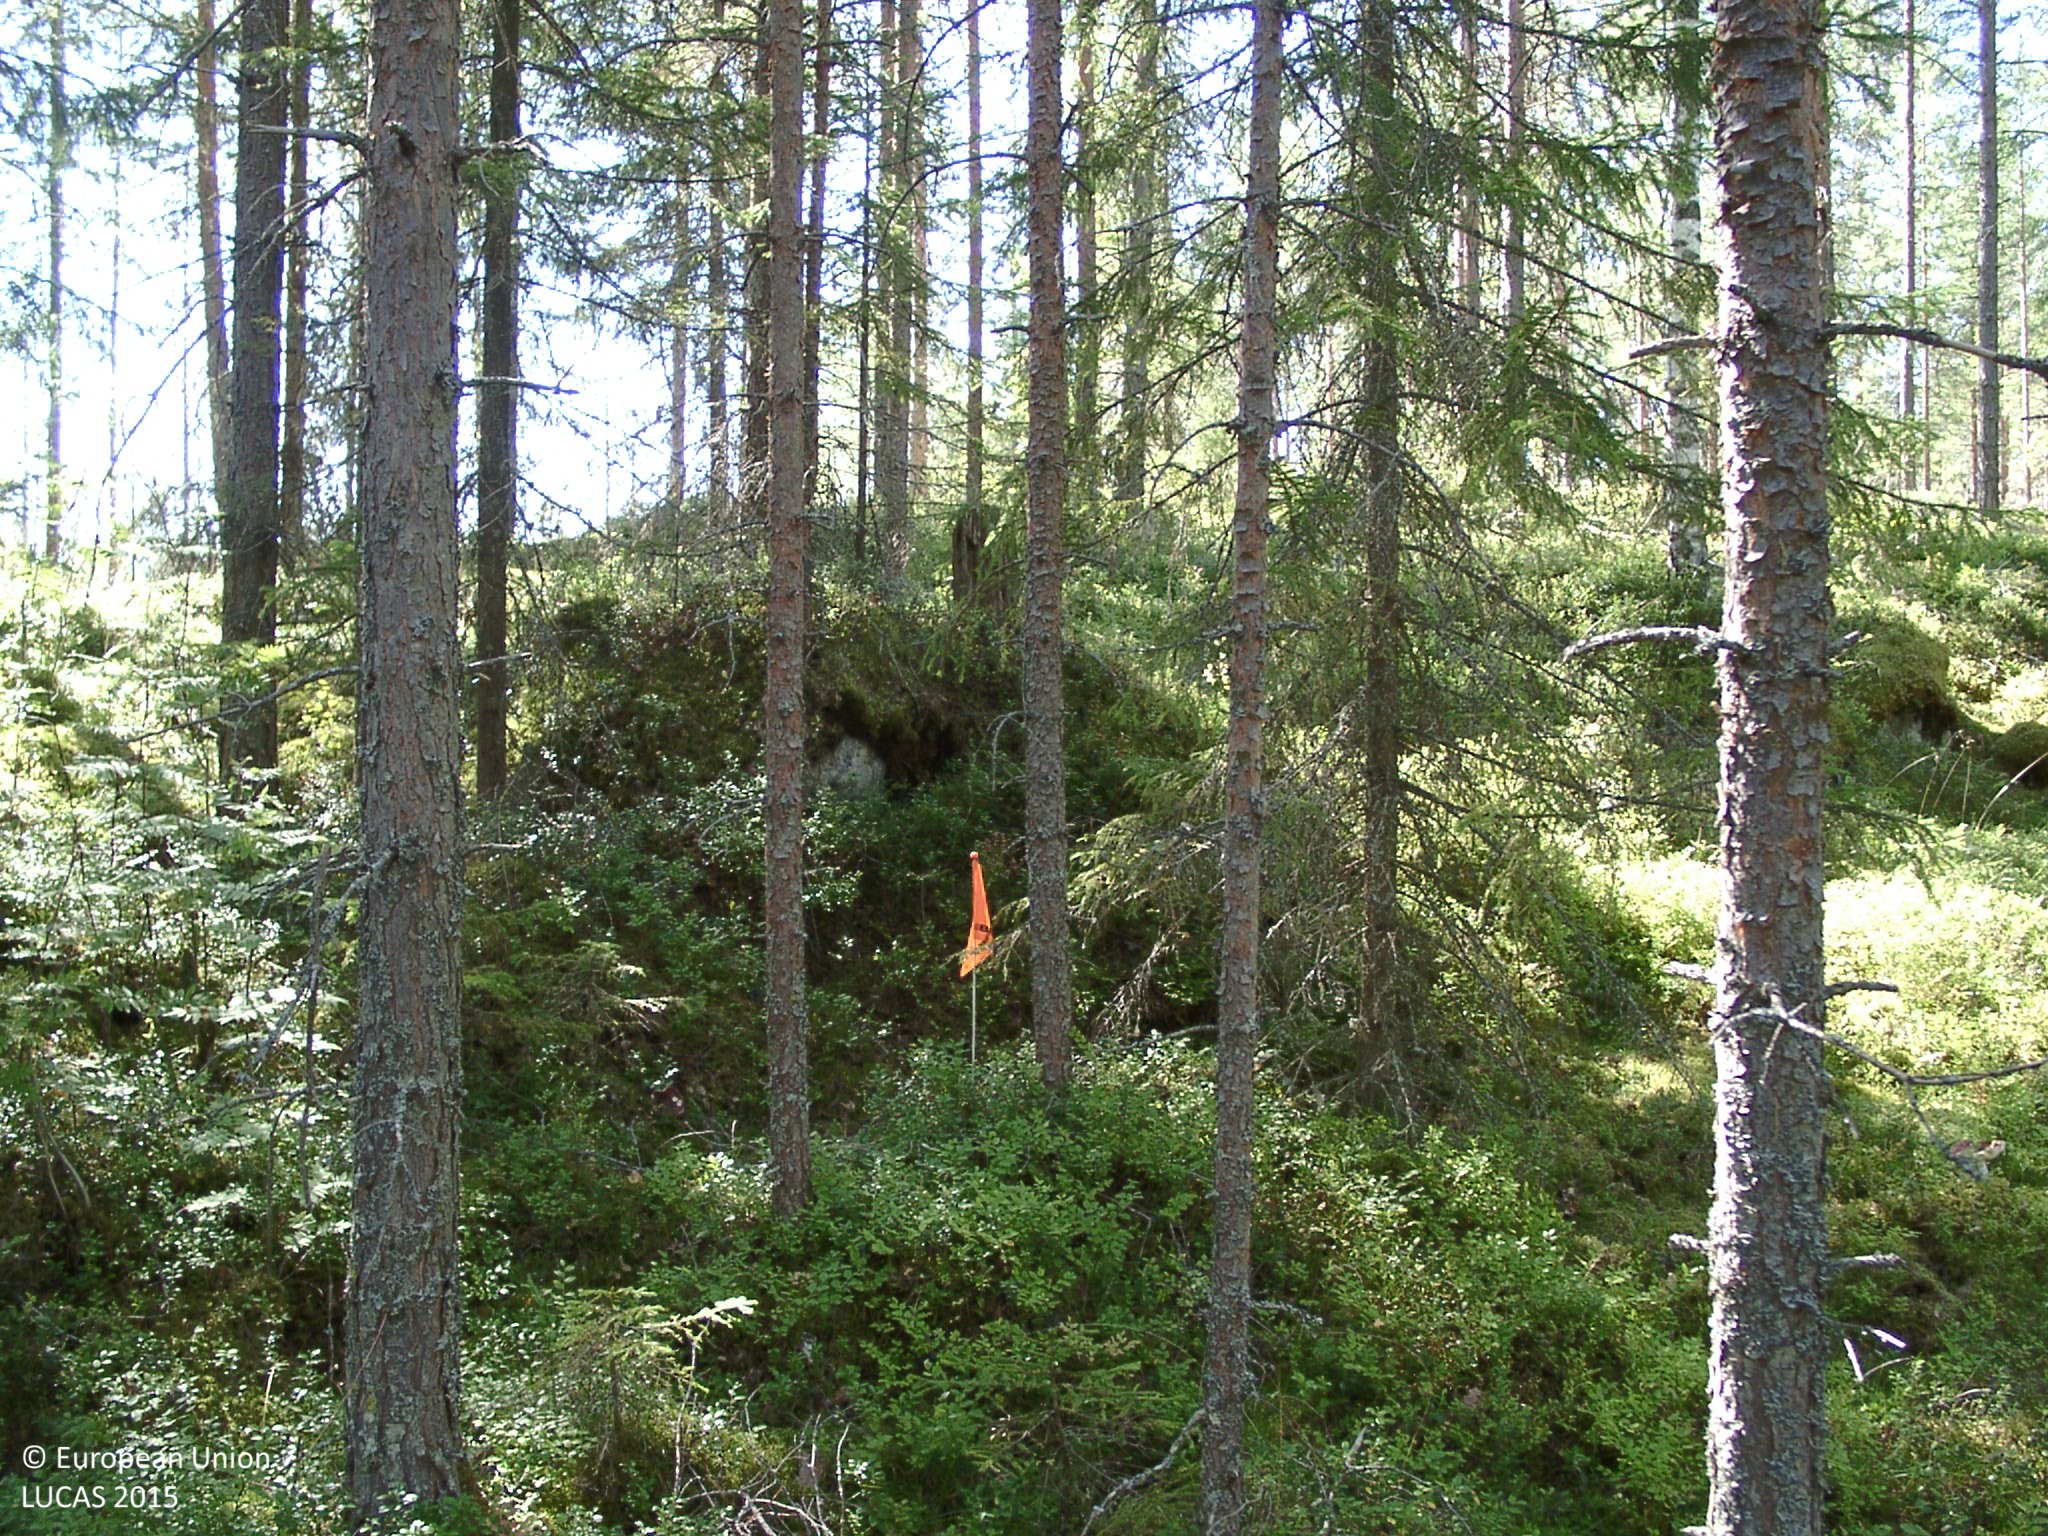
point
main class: Woodland
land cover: Other coniferous woodland
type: boreal forest
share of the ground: 50 - 75 %
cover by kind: coniferous forest trees 60 %, shrubs 15 %, lichens and mosses 15 %, broadleaved forest trees 10 %
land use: Forestry
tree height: > 5 m
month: August
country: FI
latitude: 61.9552
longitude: 24.9176
